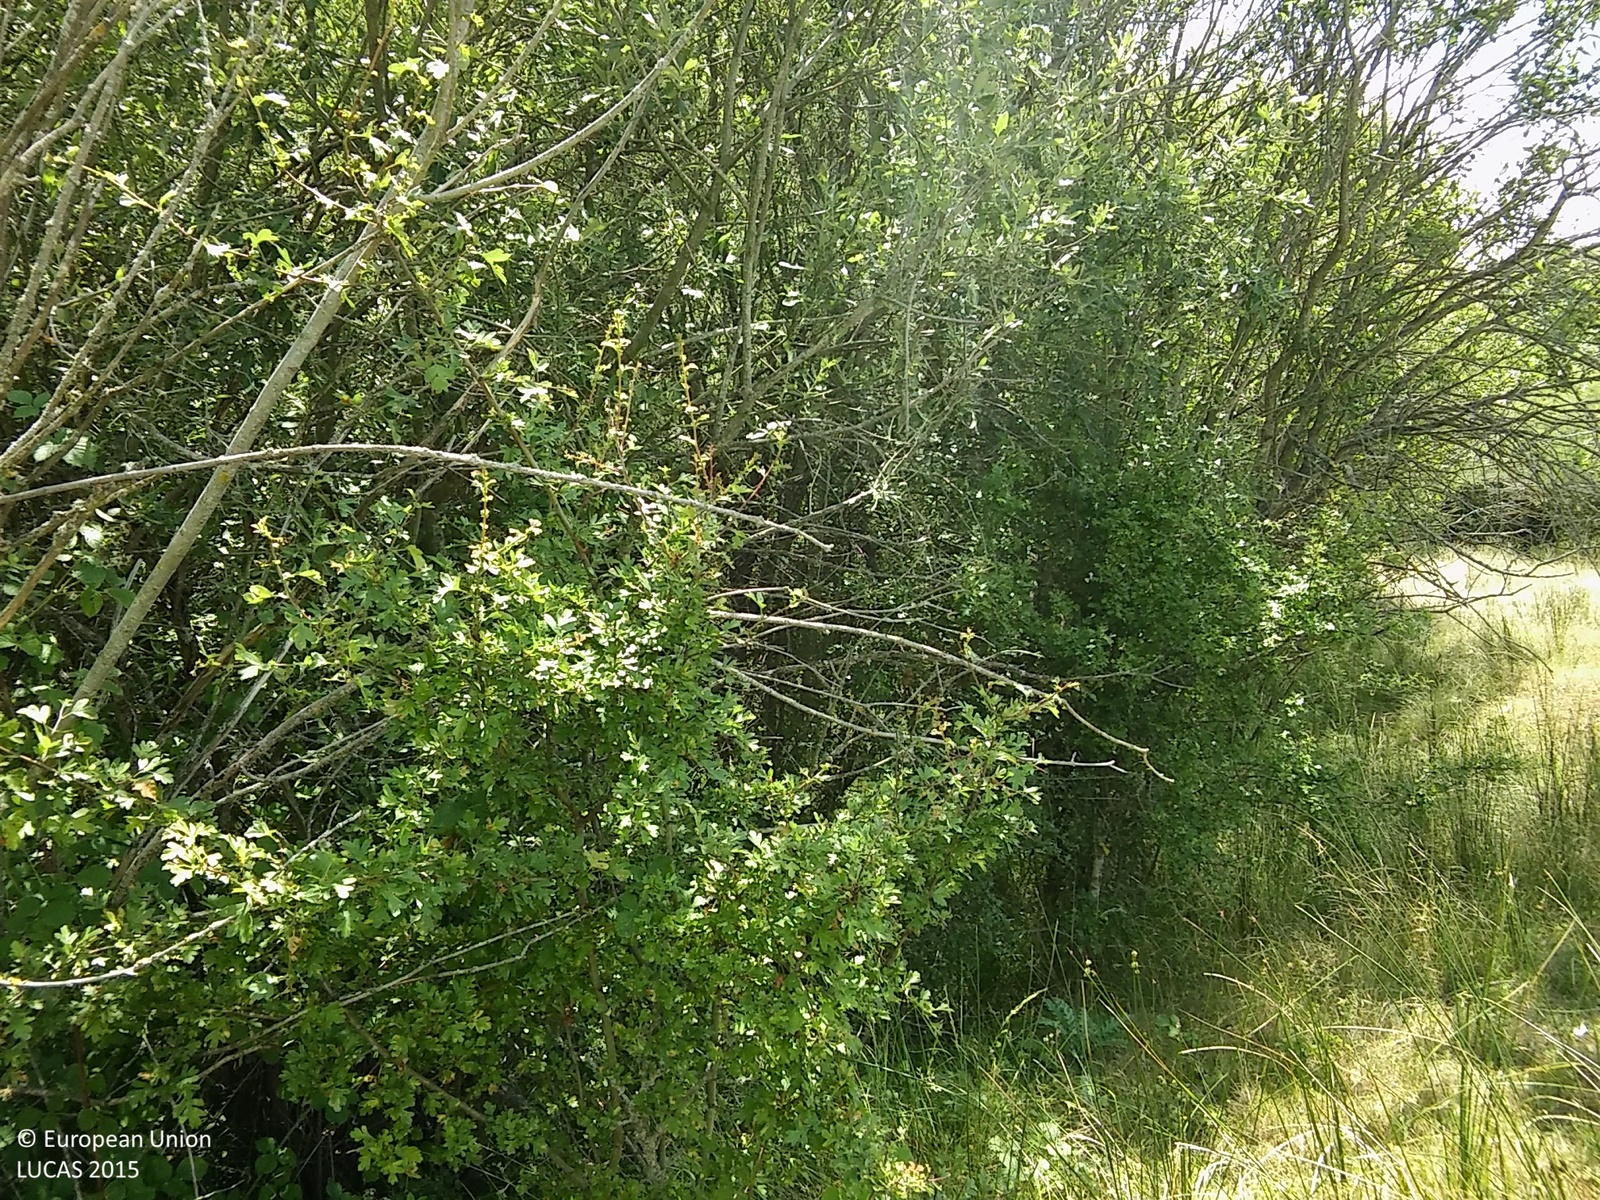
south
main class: Woodland
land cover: Broadleaved woodland
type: floodplain forest
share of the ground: 50 - 75 %
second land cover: Grassland without tree/shrub cover
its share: 25 - 50 %
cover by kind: broadleaved forest trees 60 %, herbaceous plants 35 %, shrubs 5 %
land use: Forestry
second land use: Agriculture (excluding fallow land and kitchen gardens)
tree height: > 5 m
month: June
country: ES
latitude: 41.3008
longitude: -3.6751
